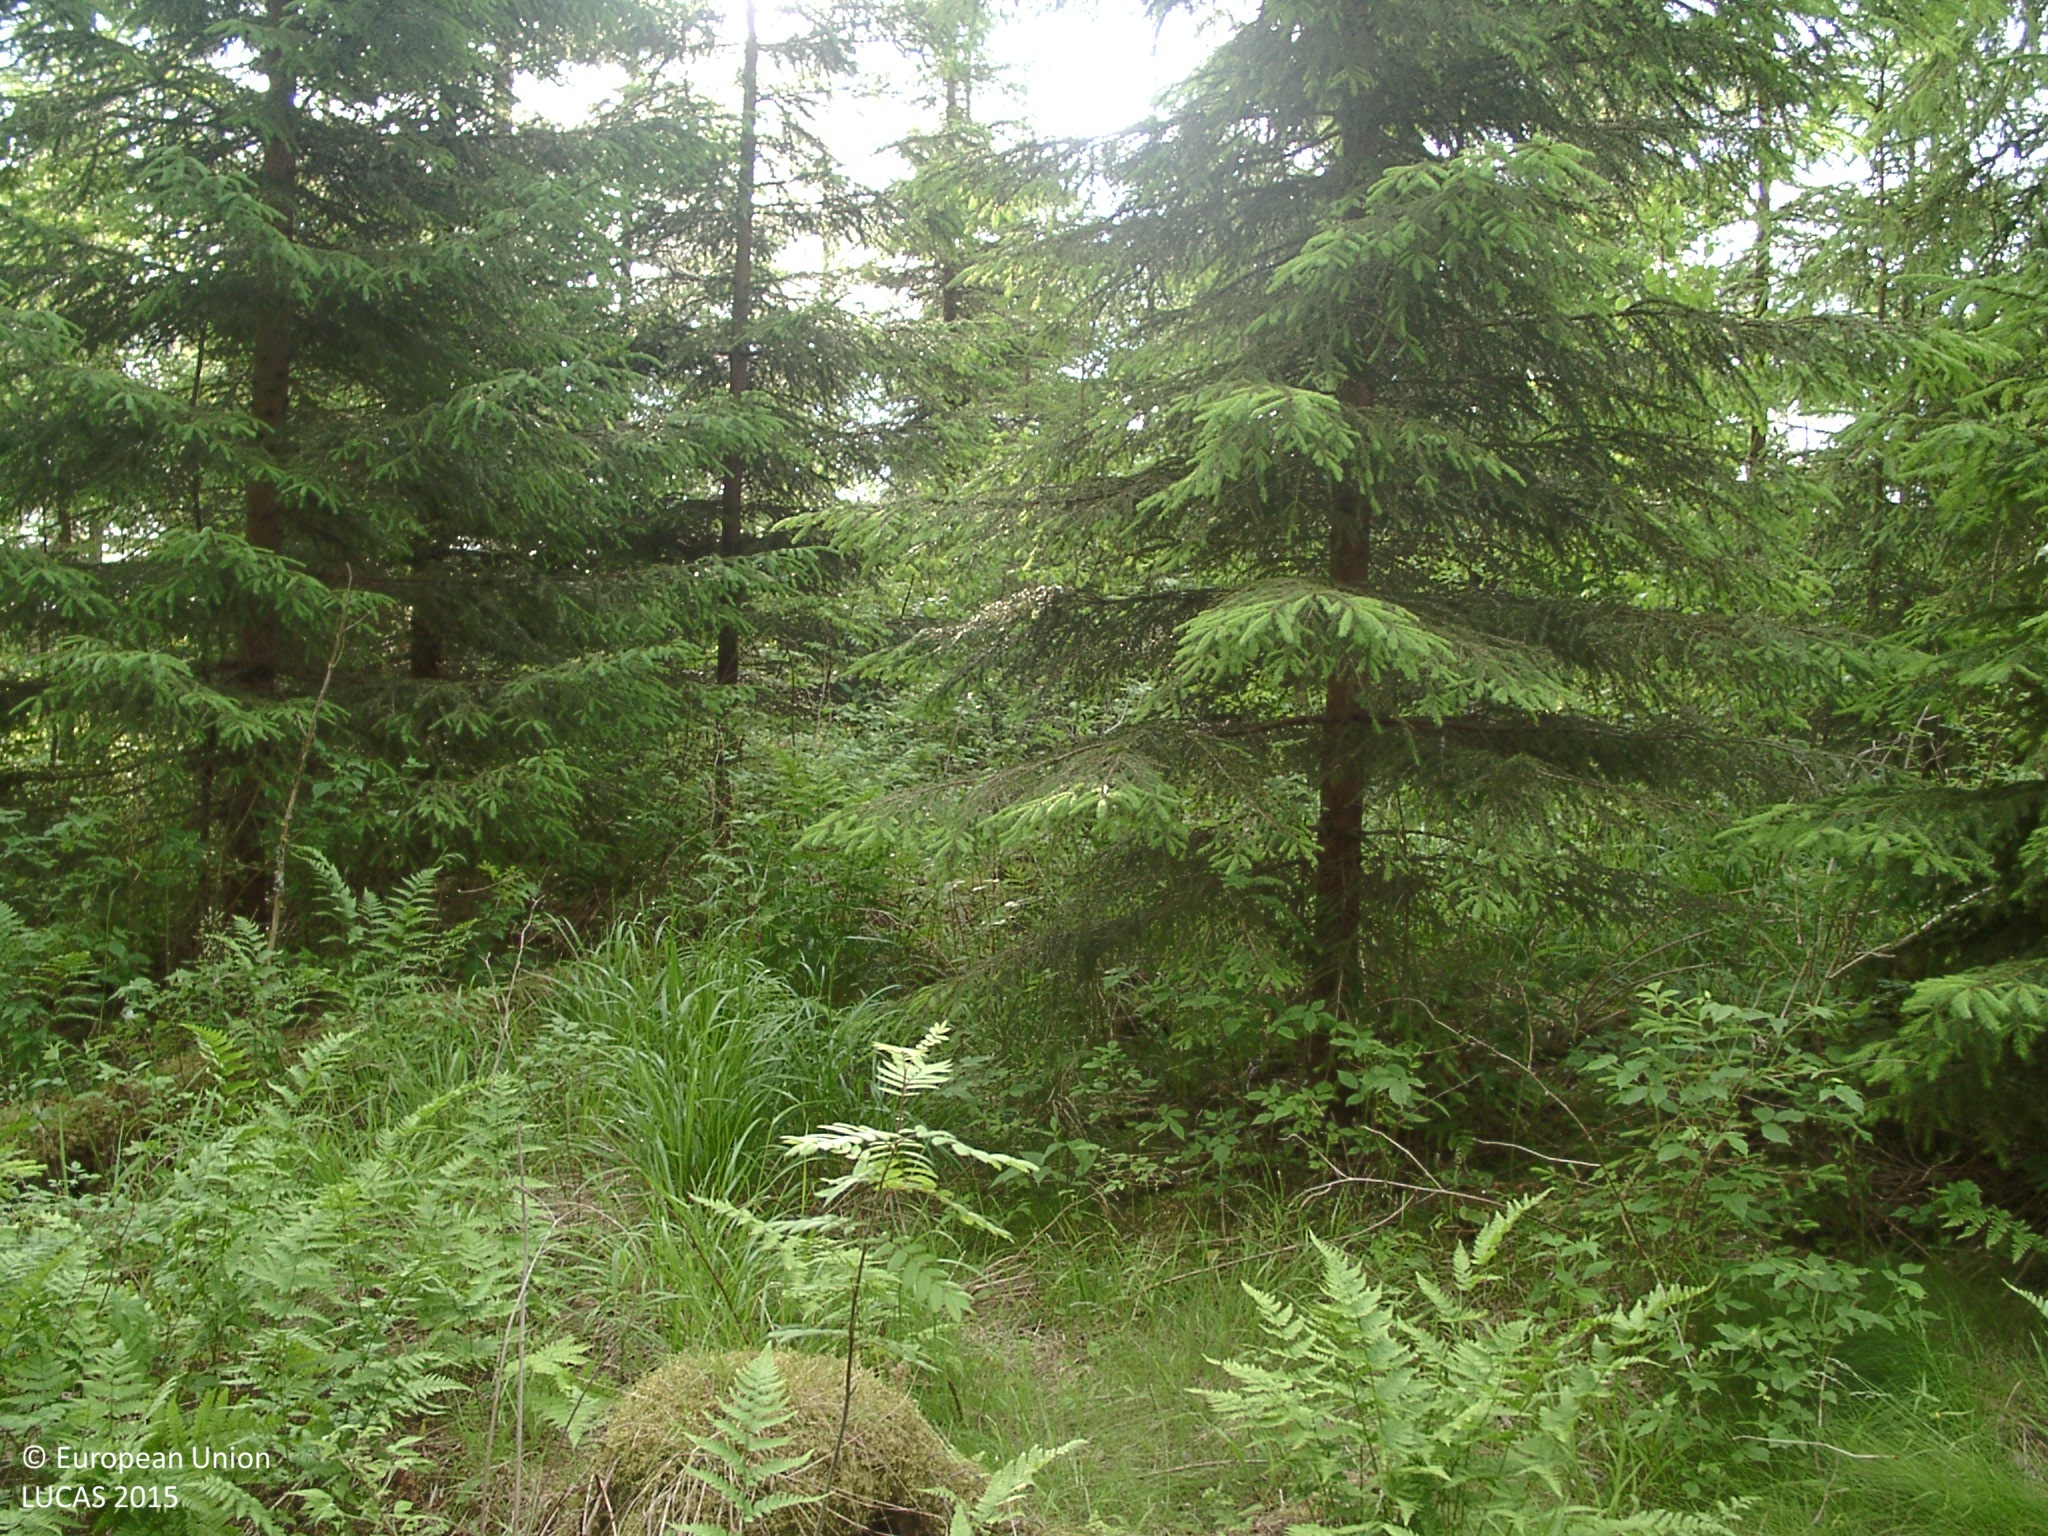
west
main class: Woodland
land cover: Spruce dominated coniferous woodland
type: boreal forest
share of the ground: 50 - 75 %
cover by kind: coniferous forest trees 55 %, shrubs 25 %, herbaceous plants 10 %, broadleaved forest trees 5 %, lichens and mosses 5 %
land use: Forestry
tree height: > 5 m
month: July
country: FI
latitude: 62.0316
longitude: 25.4244
